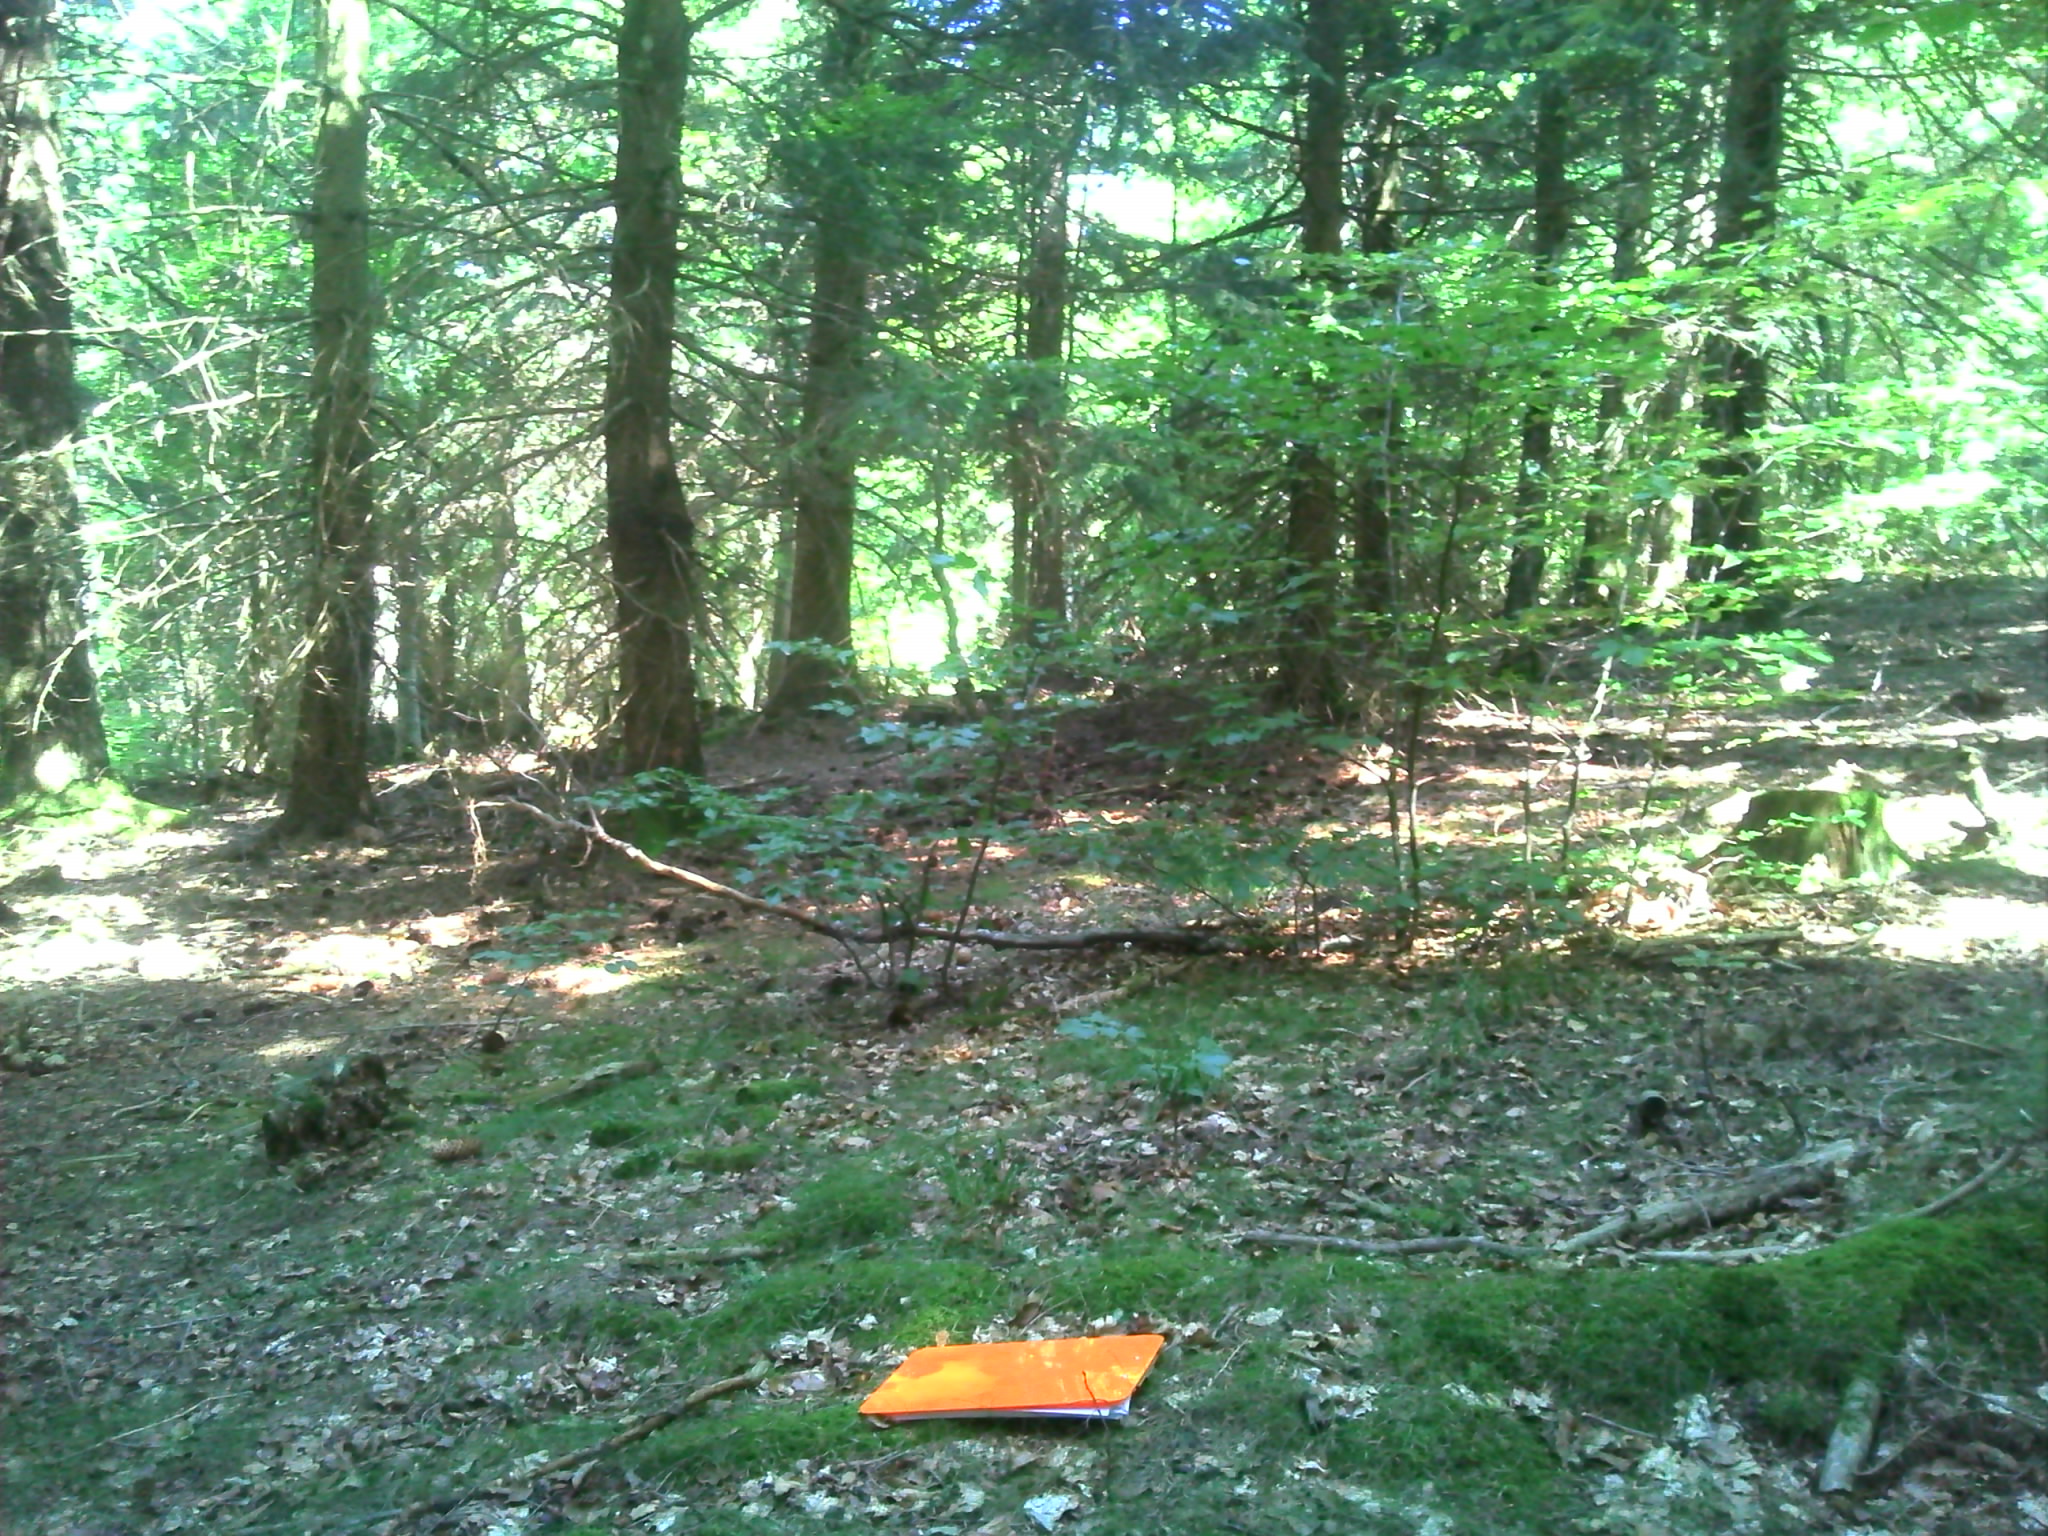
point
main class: Woodland
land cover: Spruce dominated mixed woodland
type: coniferous forest of the mediterranean region
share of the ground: > 75 %
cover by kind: coniferous forest trees 40 %, broadleaved forest trees 30 %, consolidated bare surface 15 %, herbaceous plants 10 %, lichens and mosses 5 %
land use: Forestry
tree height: > 5 m
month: July
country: FR
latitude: 44.0611
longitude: 3.5780
